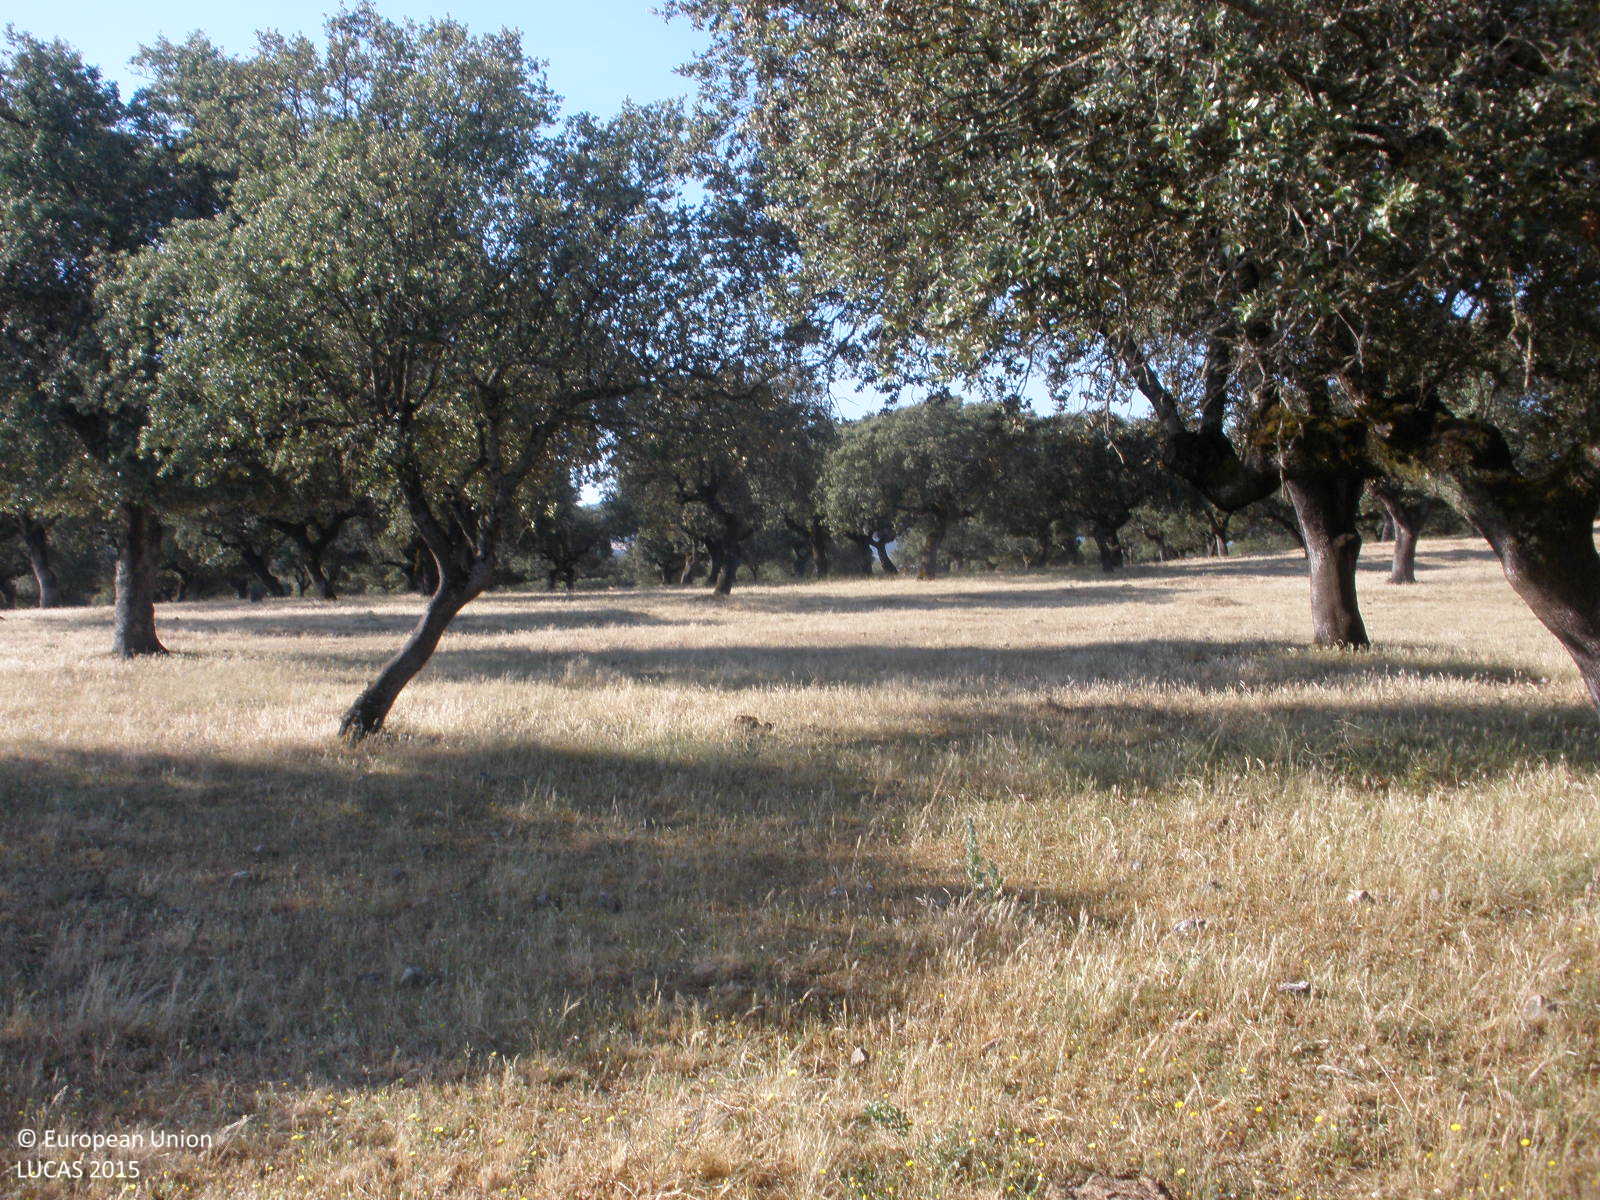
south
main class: Woodland
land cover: Broadleaved woodland
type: broadleaved evergreen forest
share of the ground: 25 - 50 %
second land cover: Grassland without tree/shrub cover
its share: > 75 %
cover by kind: herbaceous plants 70 %, broadleaved forest trees 30 %
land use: Forestry
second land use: Agriculture (excluding fallow land and kitchen gardens)
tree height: > 5 m
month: May
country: ES
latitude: 40.1685
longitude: -6.0541
